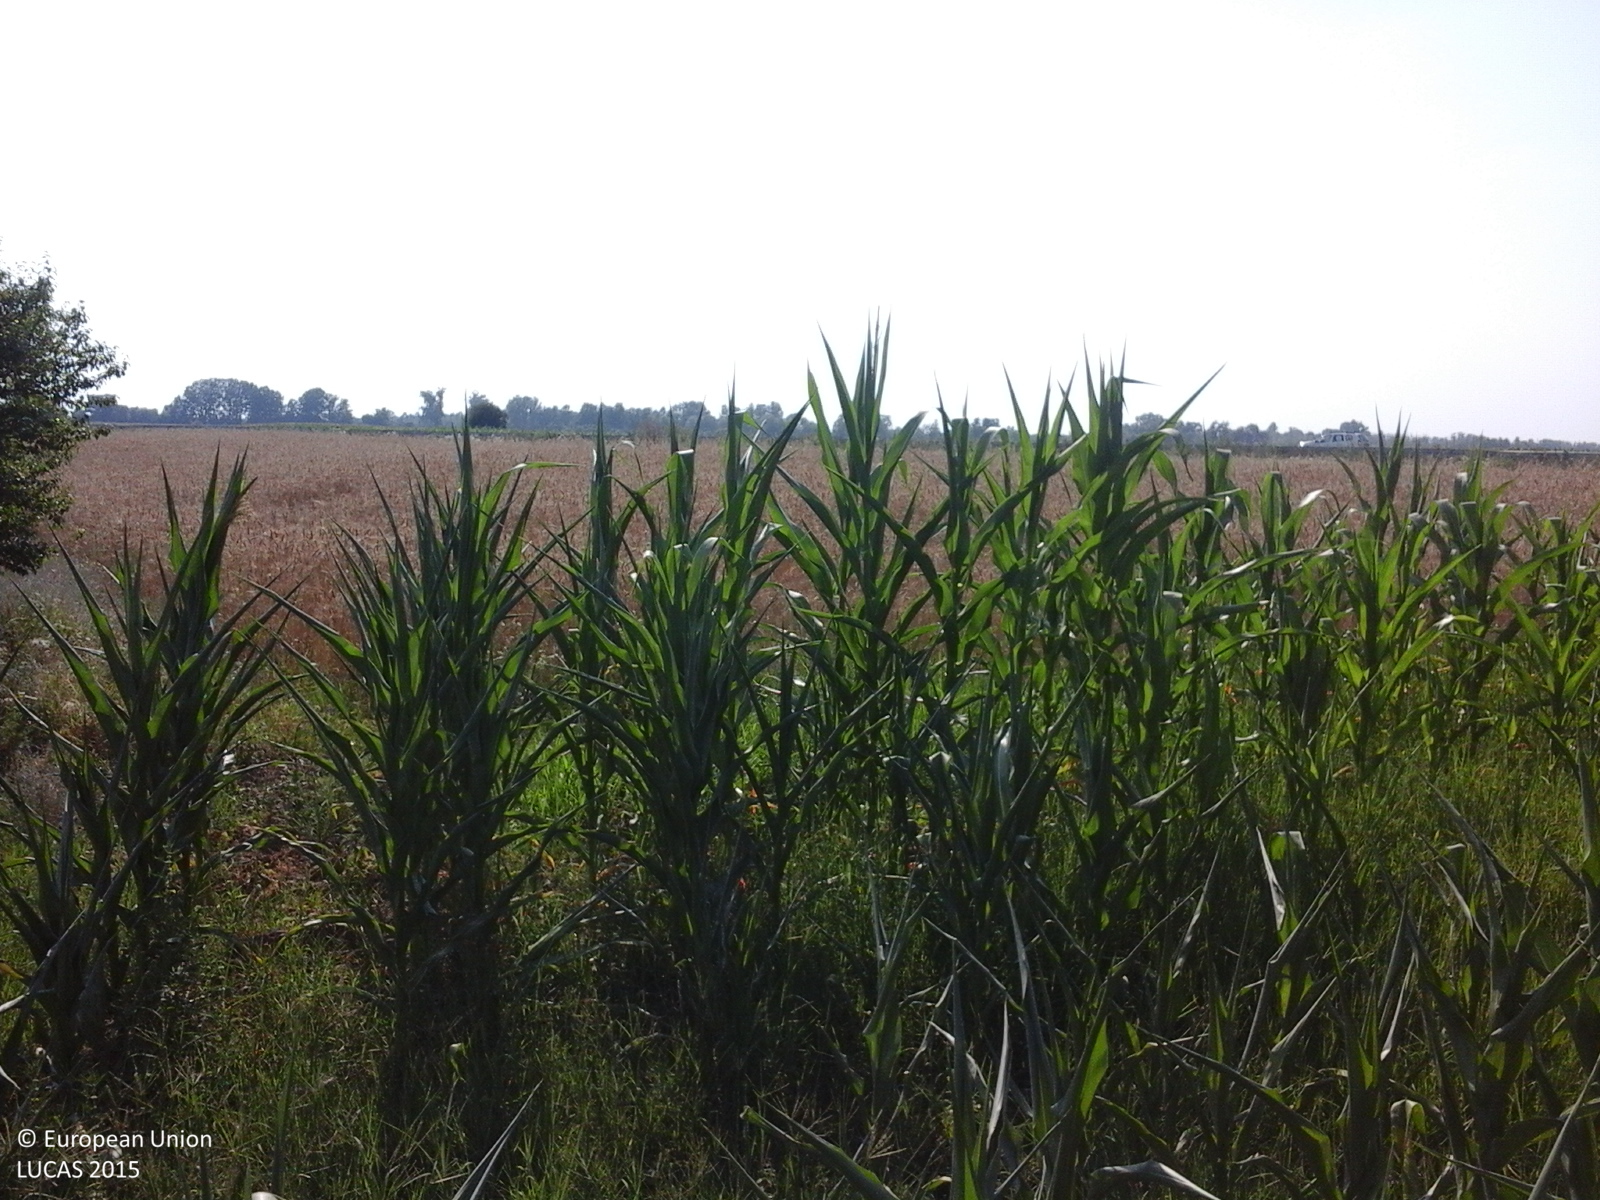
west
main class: Cropland
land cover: Maize
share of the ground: > 75 %
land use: Agriculture (excluding fallow land and kitchen gardens)
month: July
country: RO
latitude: 44.5434
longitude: 25.5622
